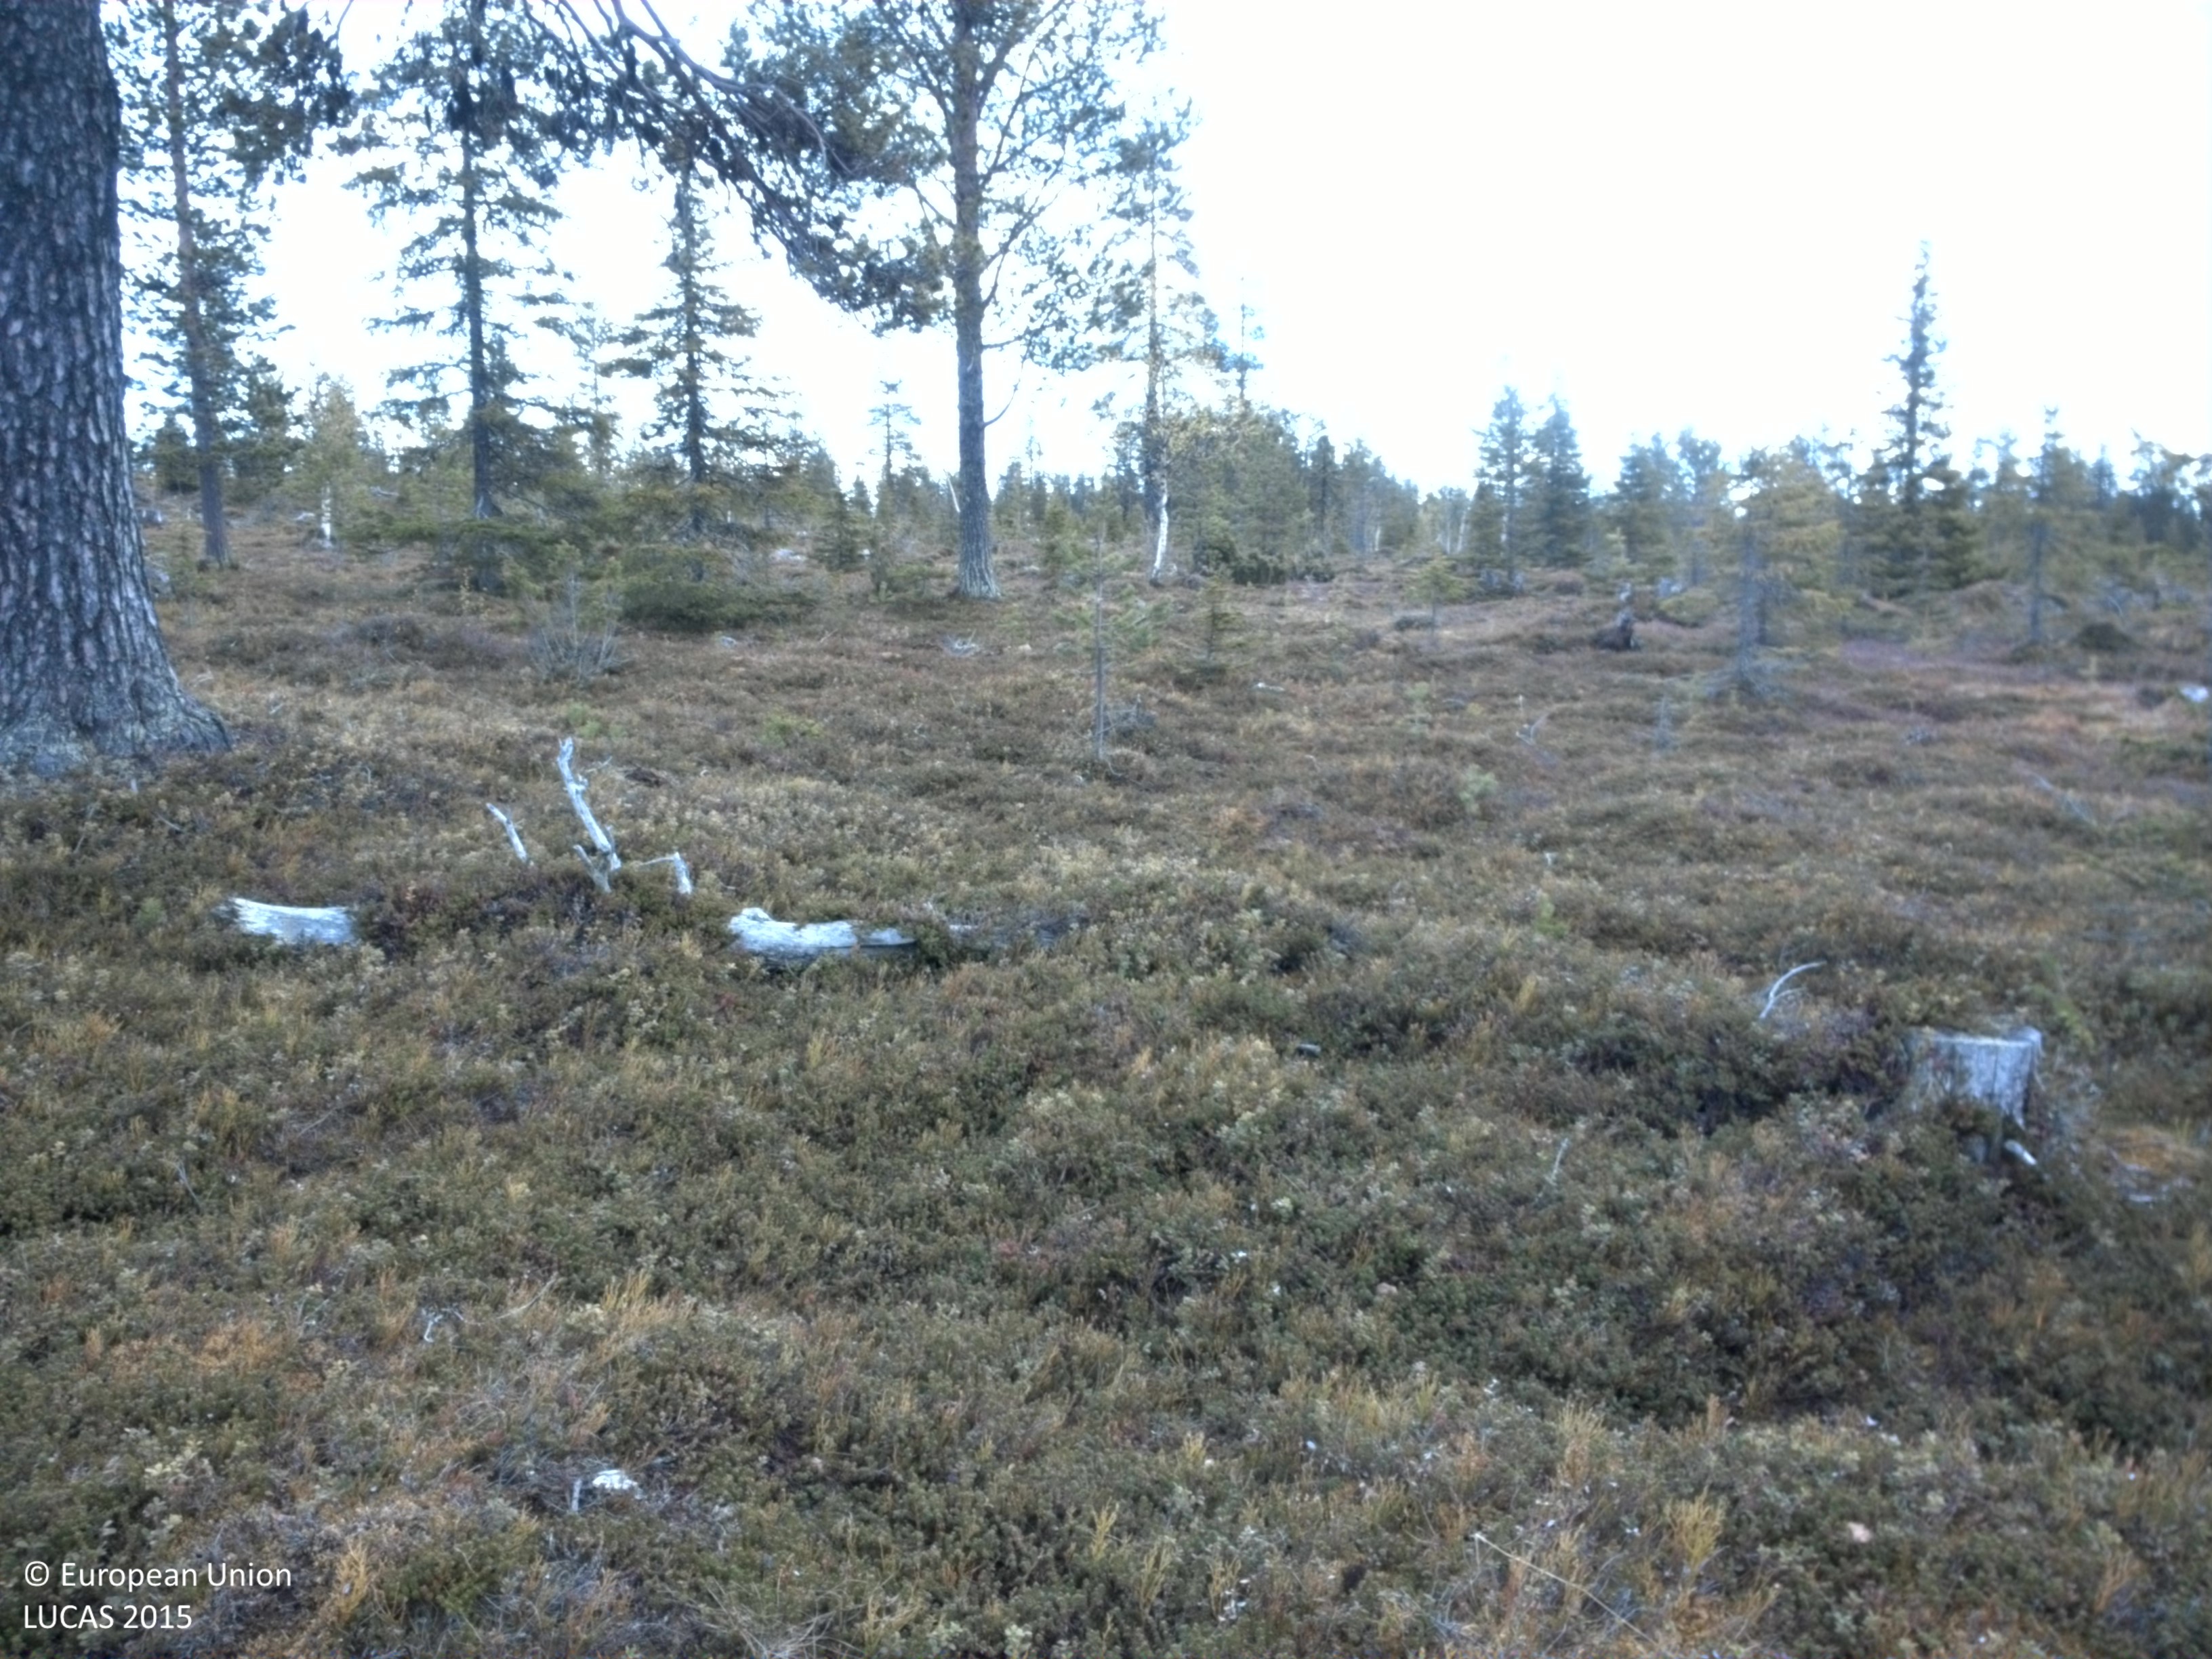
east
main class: Woodland
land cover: Pine dominated coniferous woodland
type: boreal forest
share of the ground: 10 - 25 %
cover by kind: herbaceous plants 75 %, coniferous forest trees 15 %, broadleaved forest trees 5 %, shrubs 5 %
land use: Forestry
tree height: > 5 m
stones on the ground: < 10 %
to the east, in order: Pine dominated coniferous woodland; Spruce dominated coniferous woodland; Pine dominated coniferous woodland
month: June
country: SE
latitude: 67.0157
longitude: 20.9914
